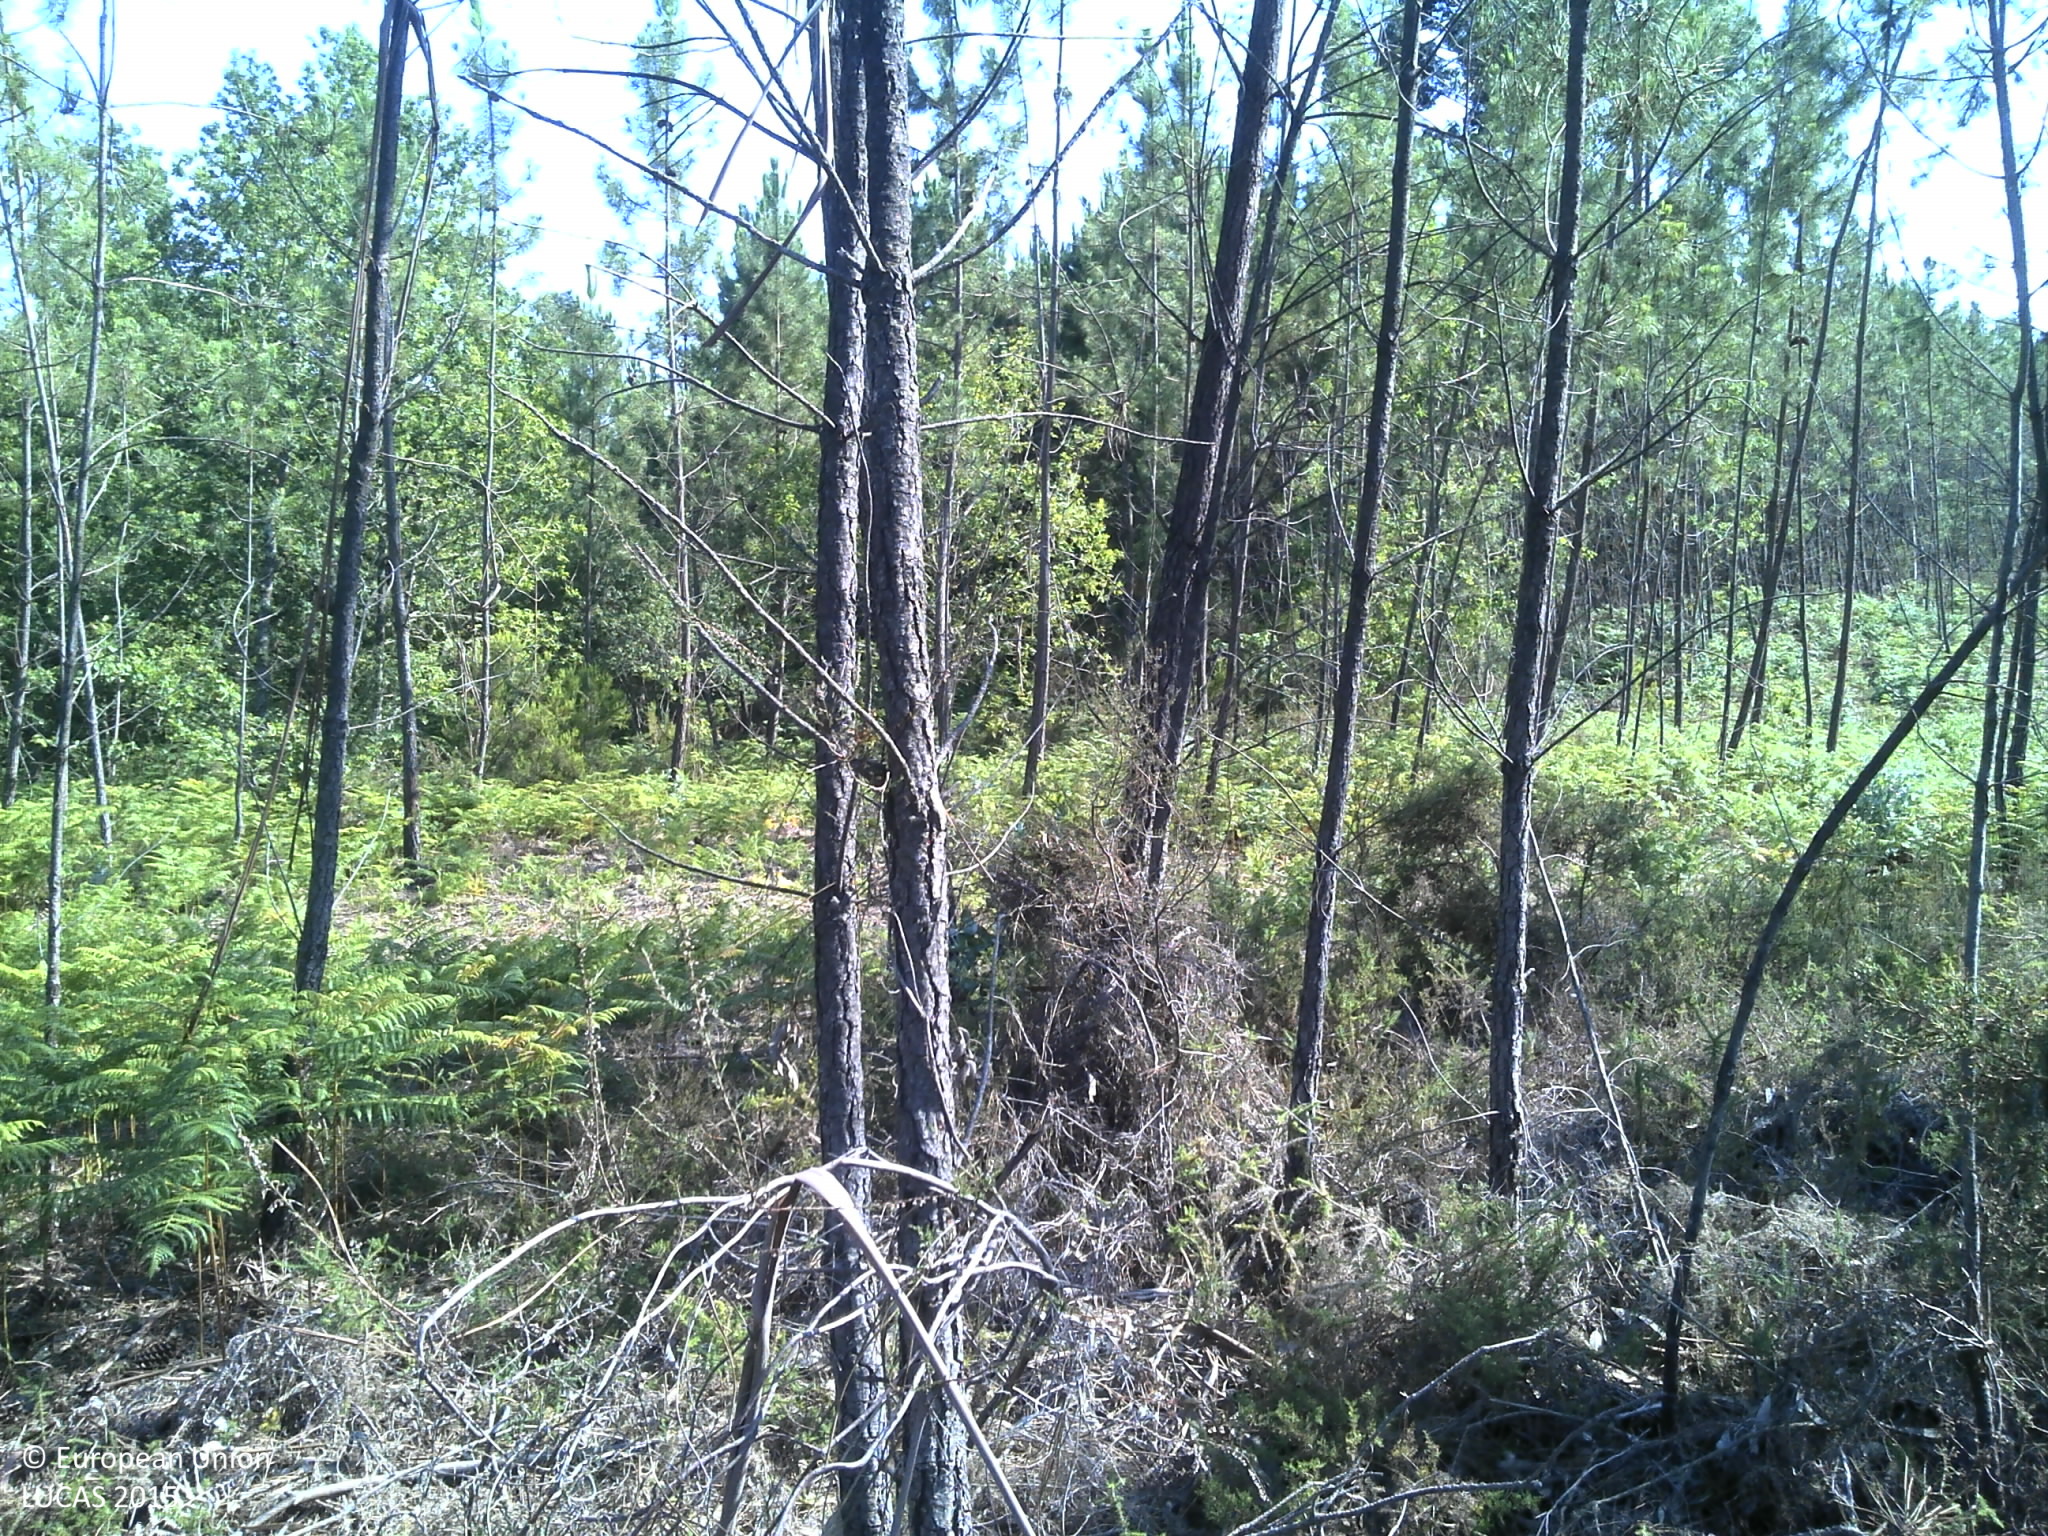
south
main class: Woodland
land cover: Pine dominated coniferous woodland
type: coniferous forest of the mediterranean region
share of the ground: 25 - 50 %
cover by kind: coniferous forest trees 45 %, shrubs 40 %, unconsolidated bare surface 10 %, herbaceous plants 5 %
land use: Forestry
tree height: > 5 m
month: June
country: PT
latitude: 40.6307
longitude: -8.0388
